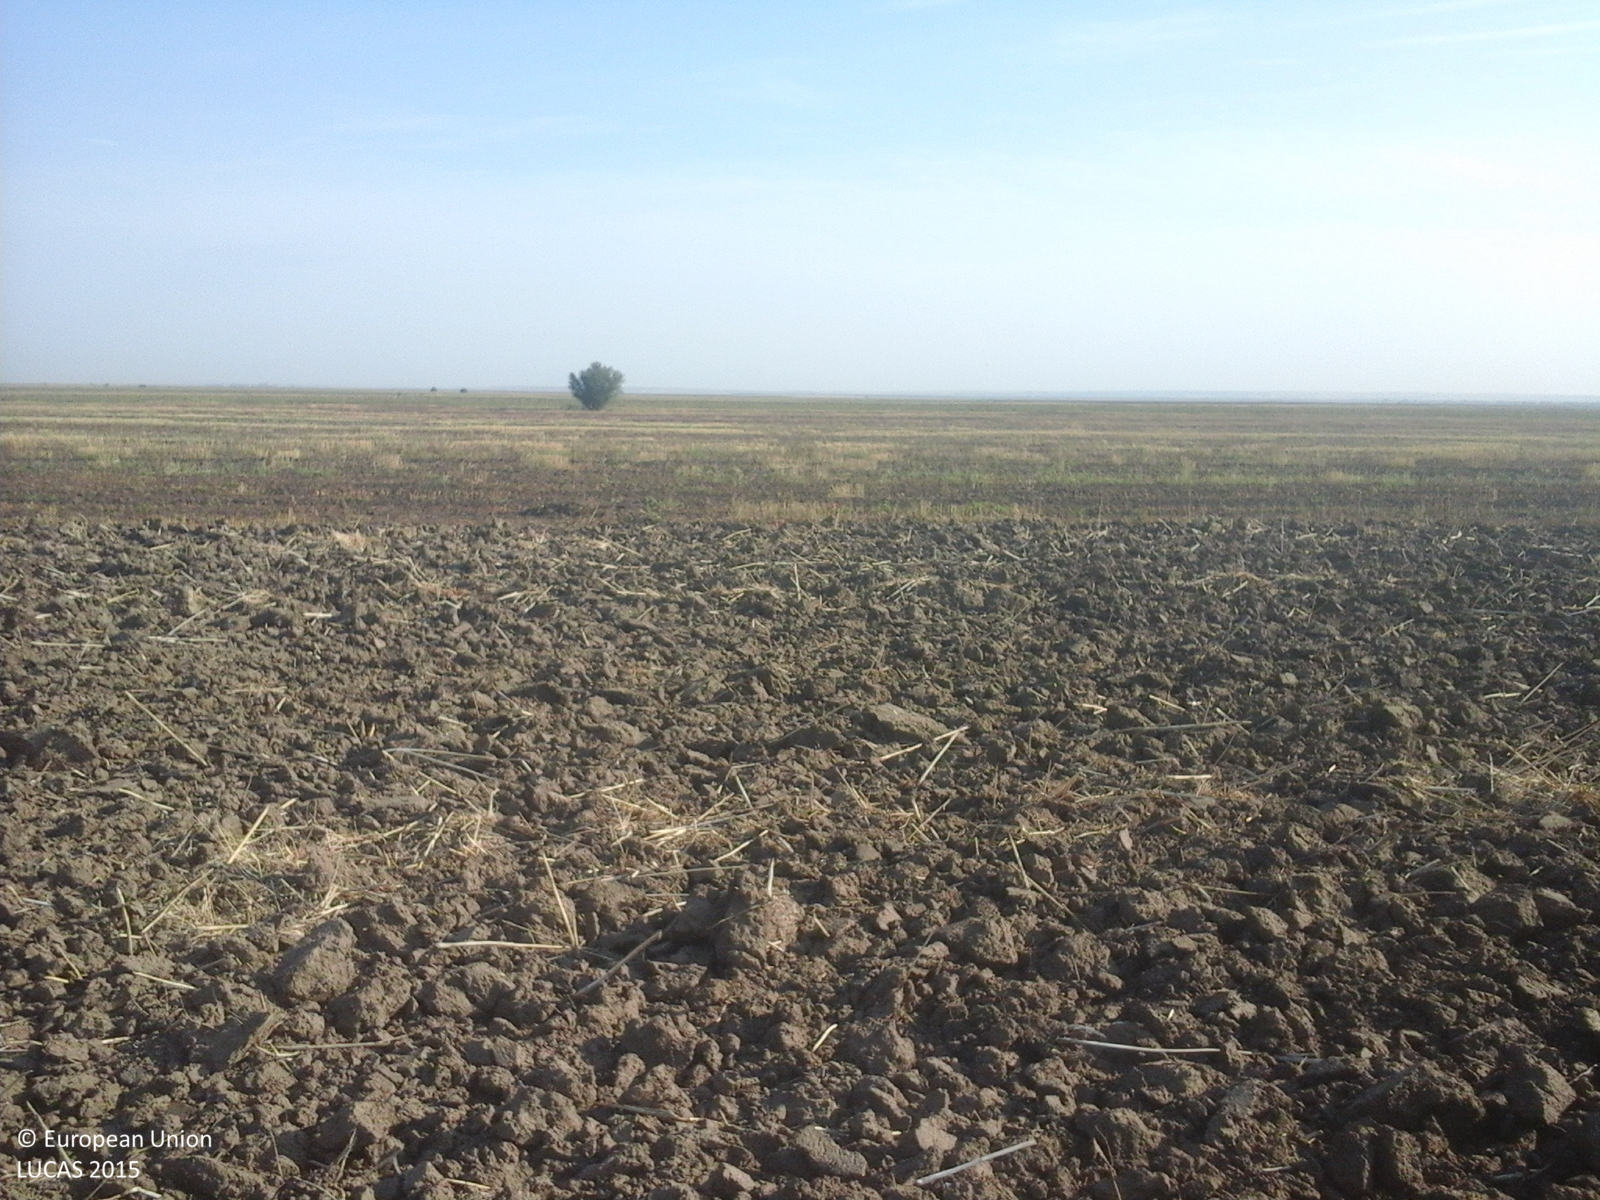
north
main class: Cropland
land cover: Rape and turnip rape
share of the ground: < 10 %
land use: Agriculture (excluding fallow land and kitchen gardens)
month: August
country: RO
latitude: 44.1661
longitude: 23.0115
